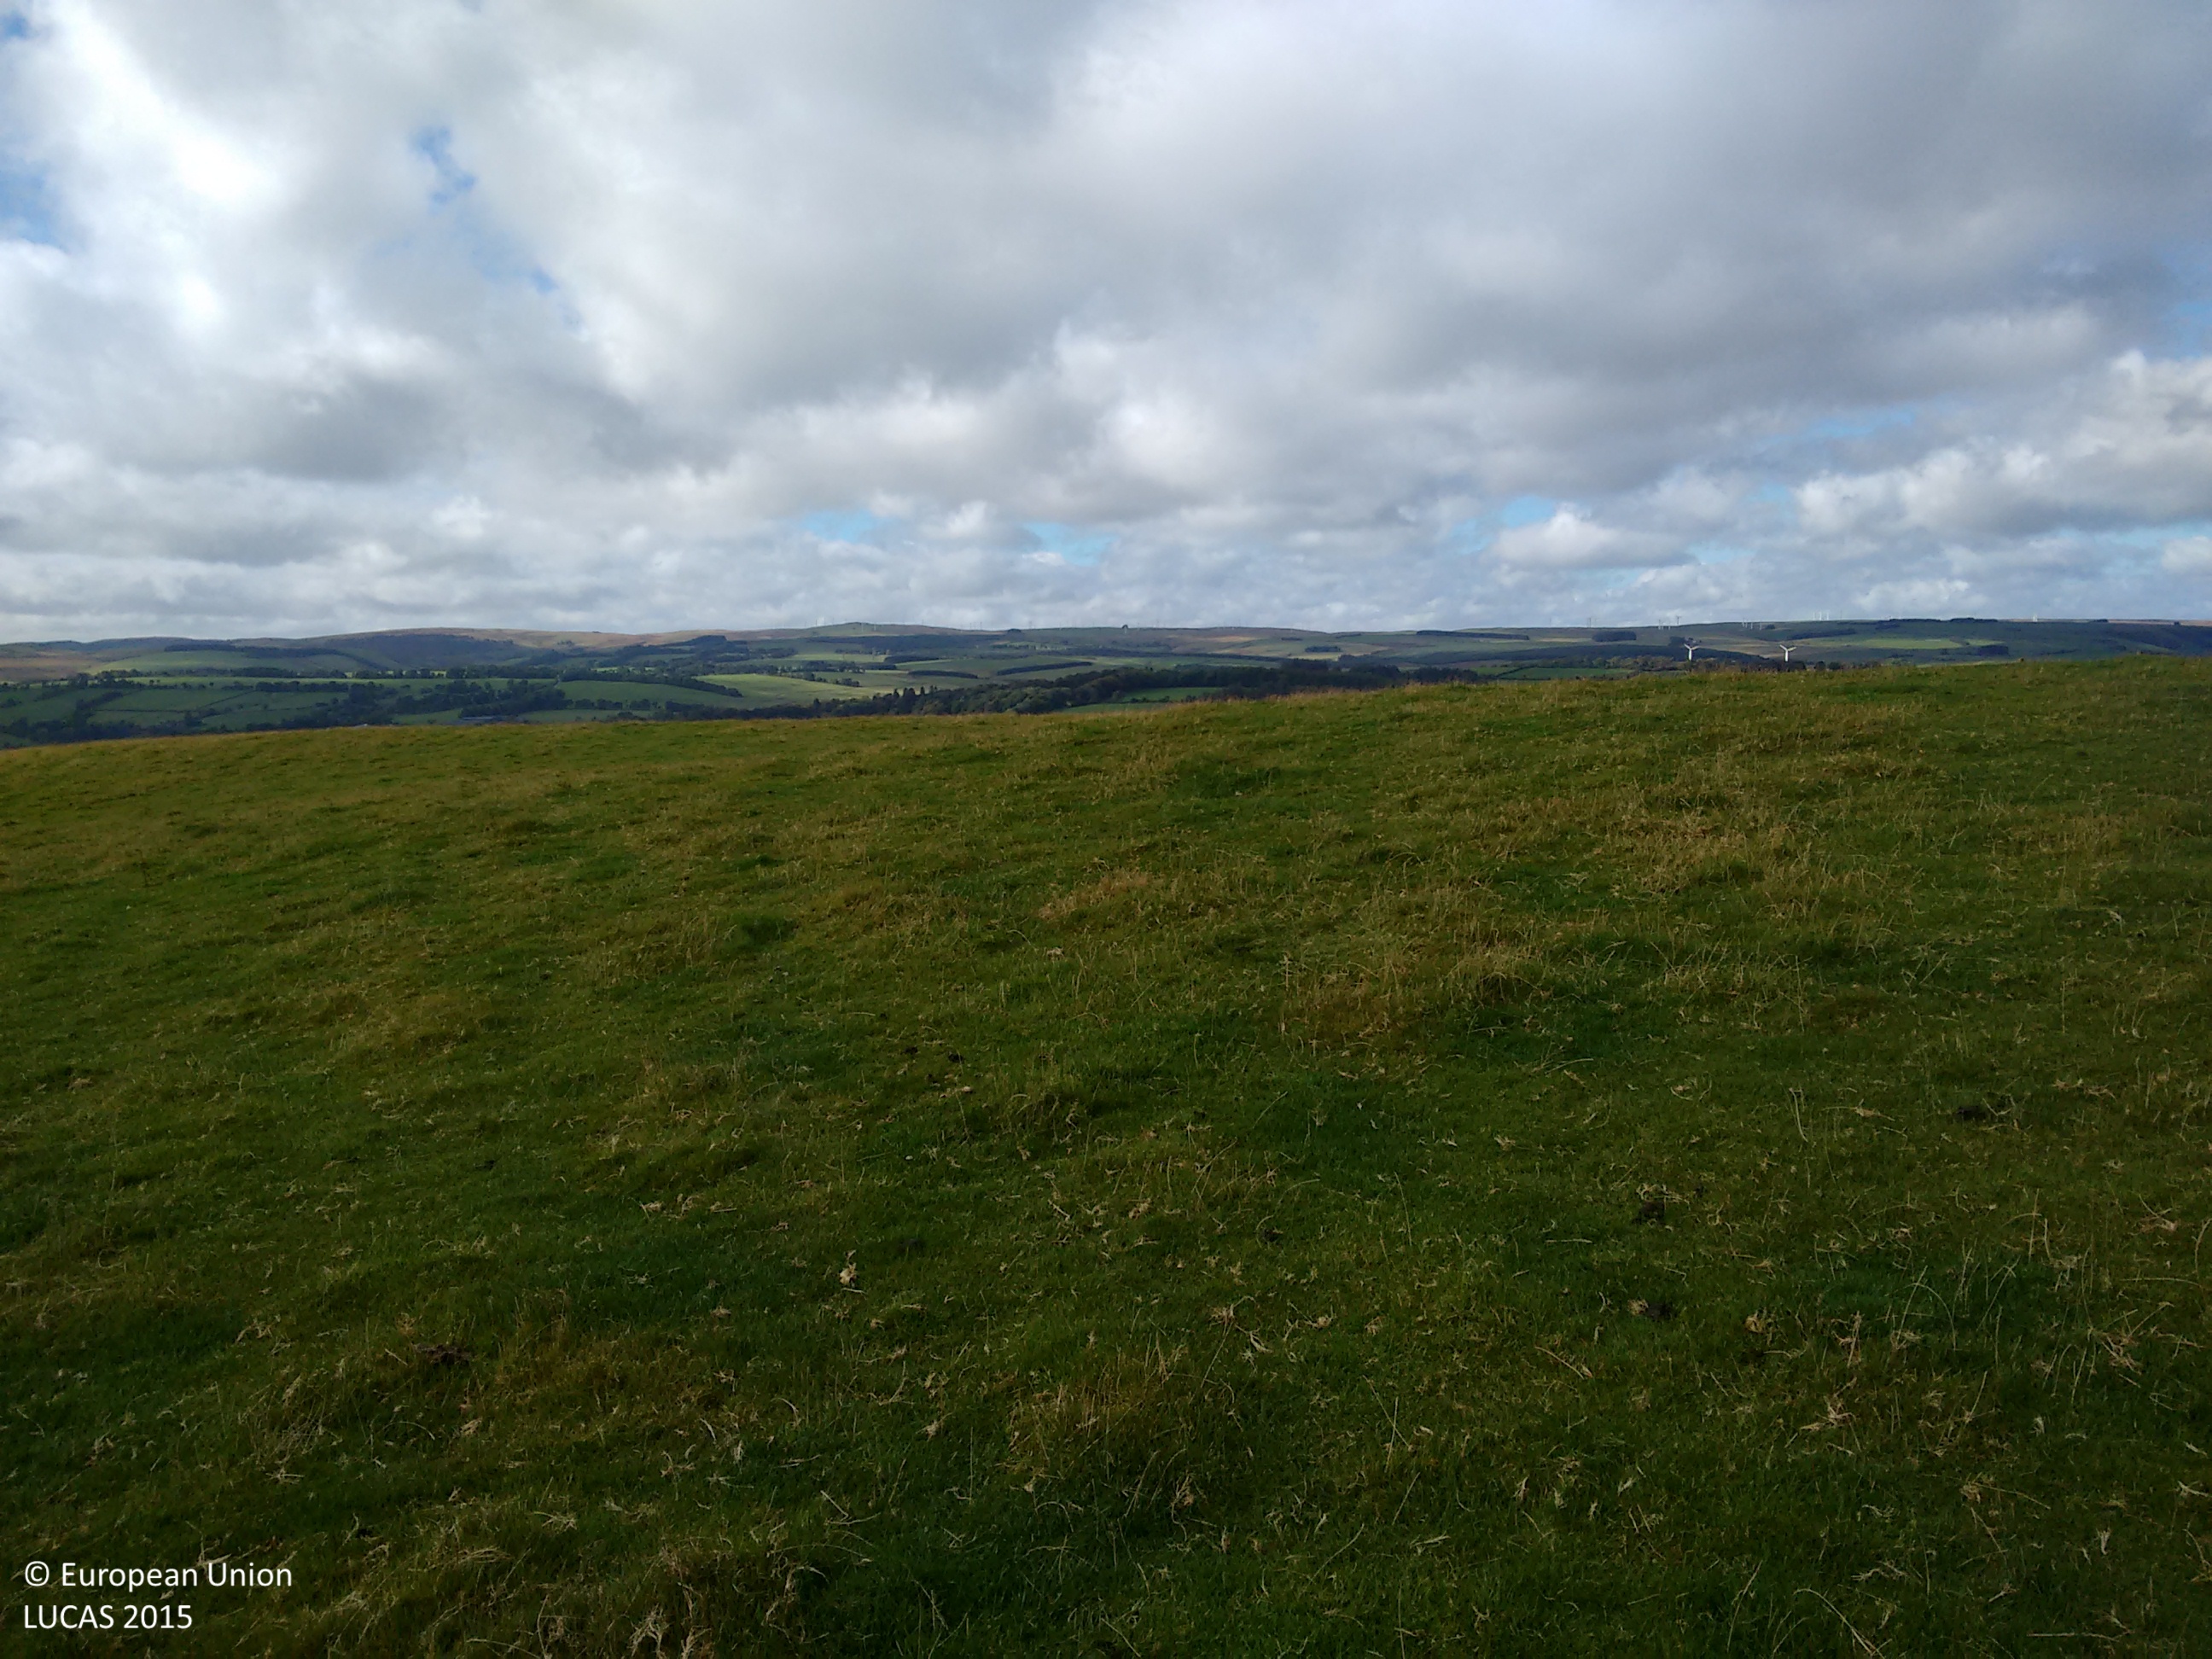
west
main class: Grassland
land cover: Grassland without tree/shrub cover
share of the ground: > 75 %
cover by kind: herbaceous plants 100 %
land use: Agriculture (excluding fallow land and kitchen gardens)
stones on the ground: < 10 %
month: October
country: GB
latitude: 52.4235
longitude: -3.3306
